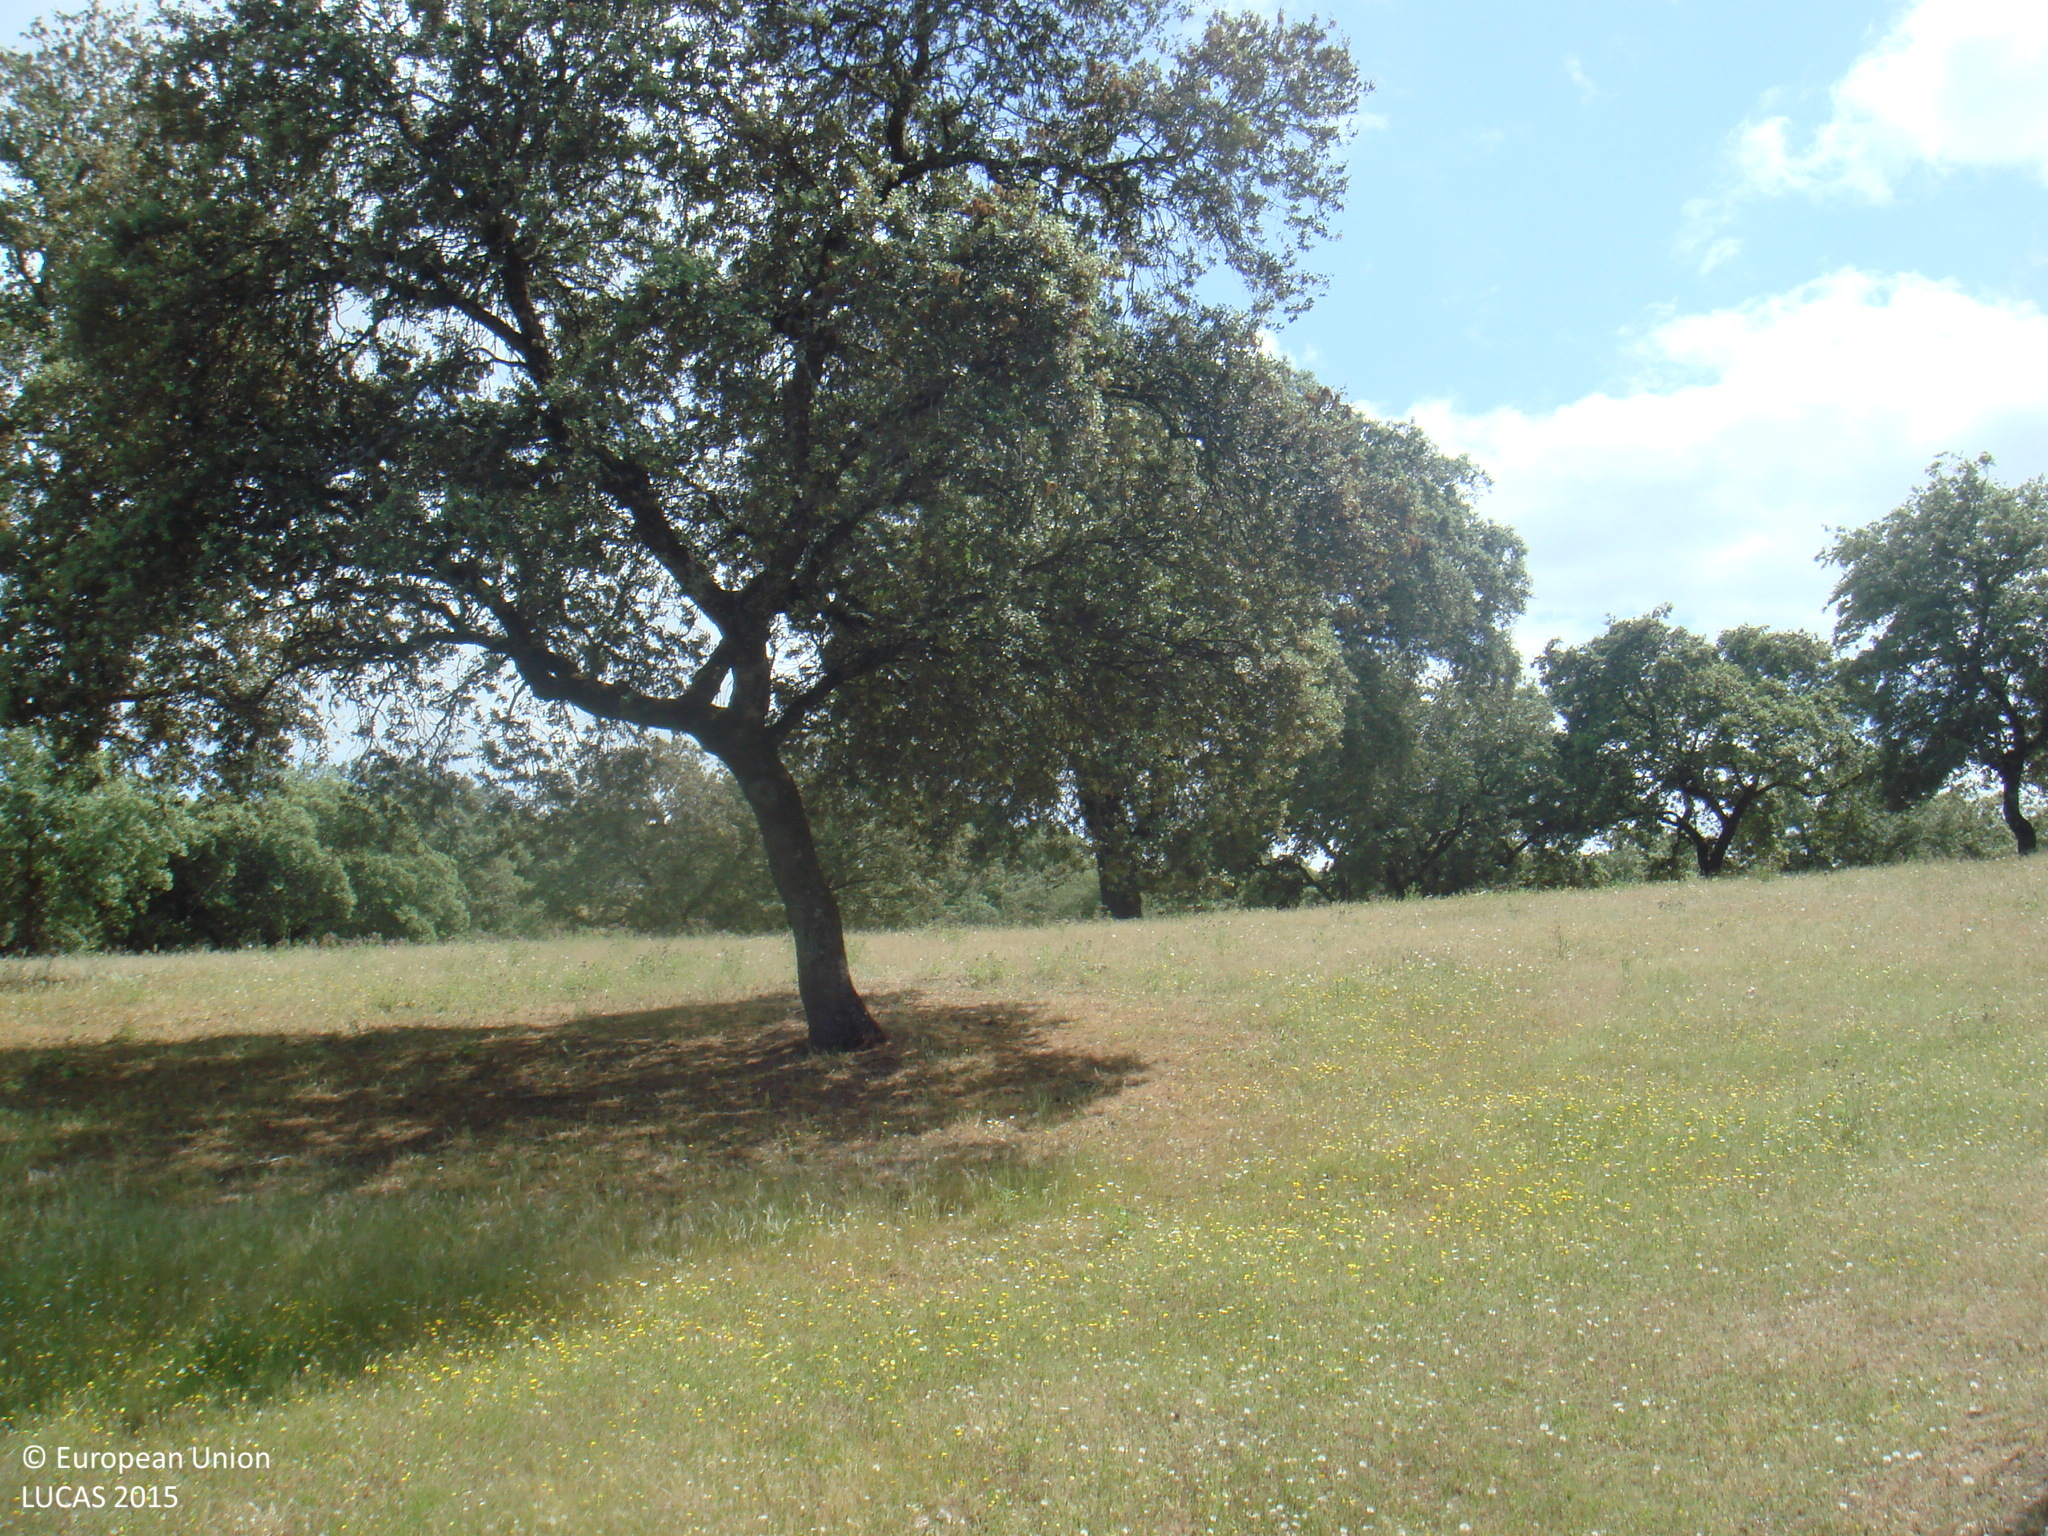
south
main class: Woodland
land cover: Broadleaved woodland
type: broadleaved evergreen forest
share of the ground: 25 - 50 %
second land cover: Spontaneously vegetated surfaces
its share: > 75 %
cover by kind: herbaceous plants 60 %, broadleaved forest trees 40 %
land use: Forestry
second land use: Agriculture (excluding fallow land and kitchen gardens)
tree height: > 5 m
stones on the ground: < 10 %
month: May
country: ES
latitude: 38.3399
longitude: -4.3749
